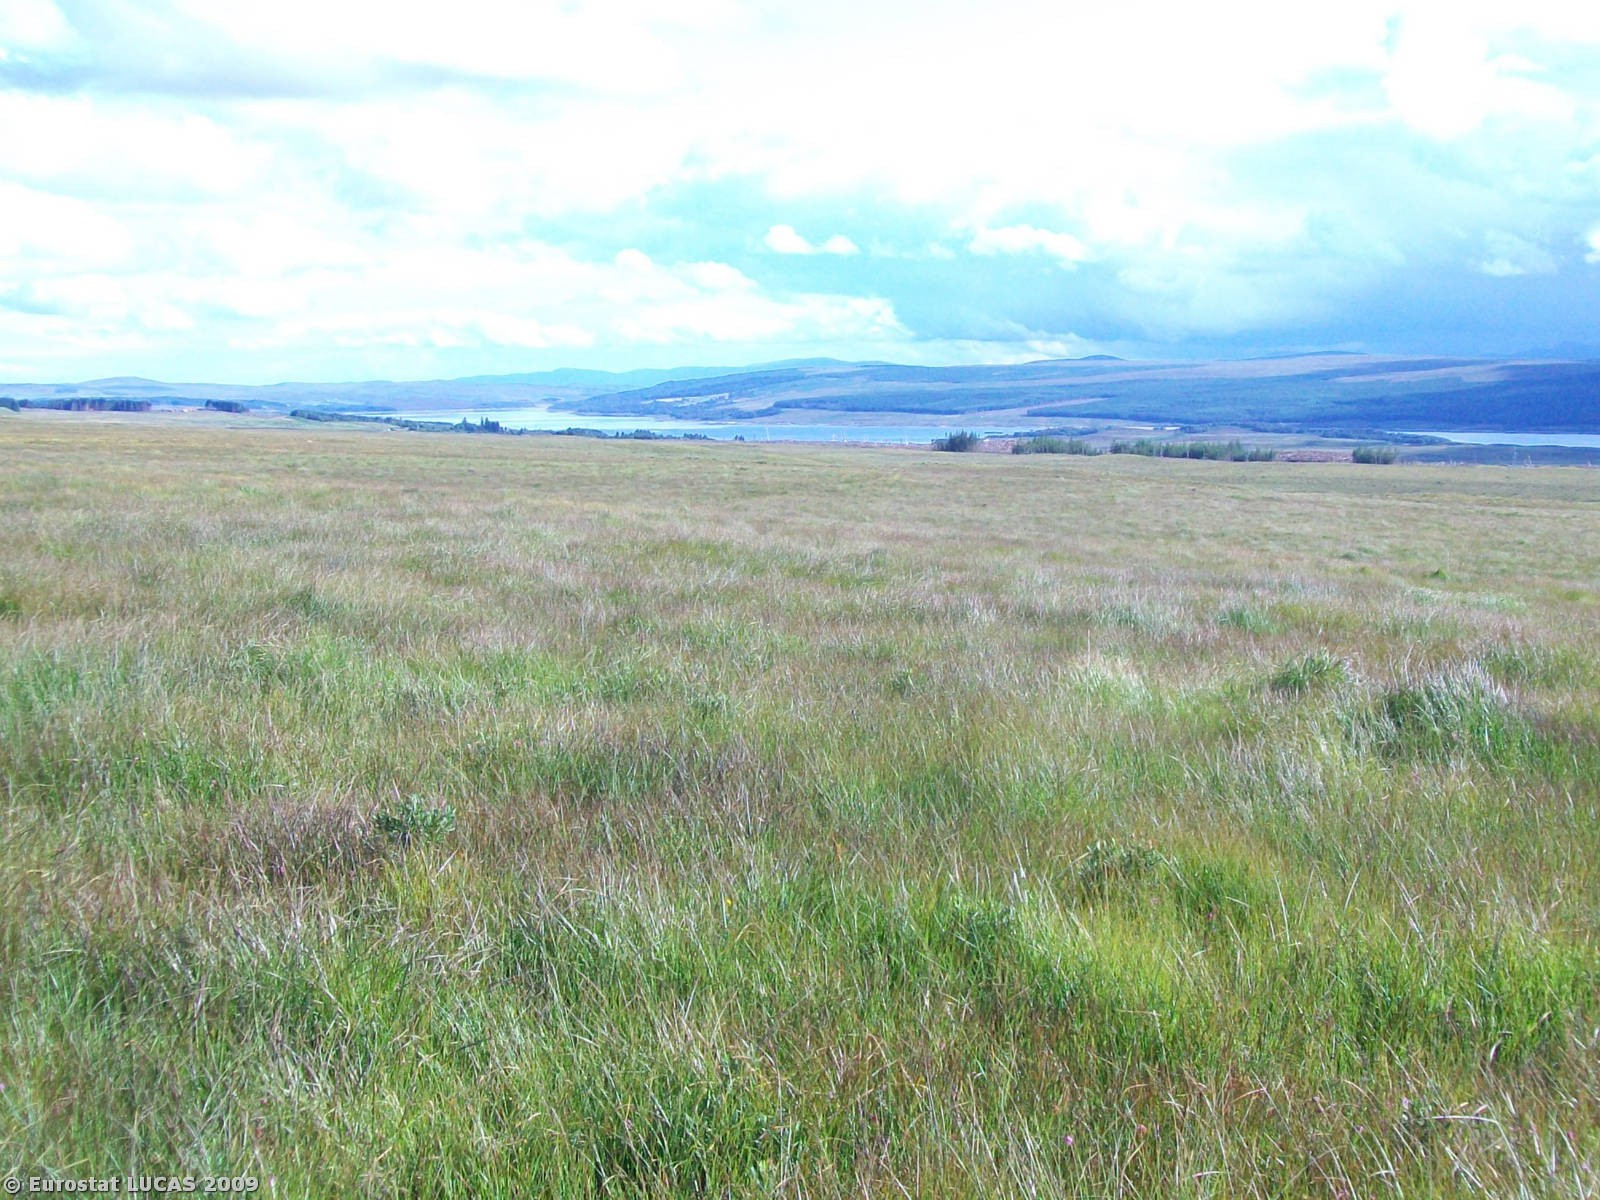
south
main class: Grassland
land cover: Grassland without tree/shrub cover
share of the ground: > 75 %
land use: Fallow land
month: August
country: GB
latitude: 58.1233
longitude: -4.5015
